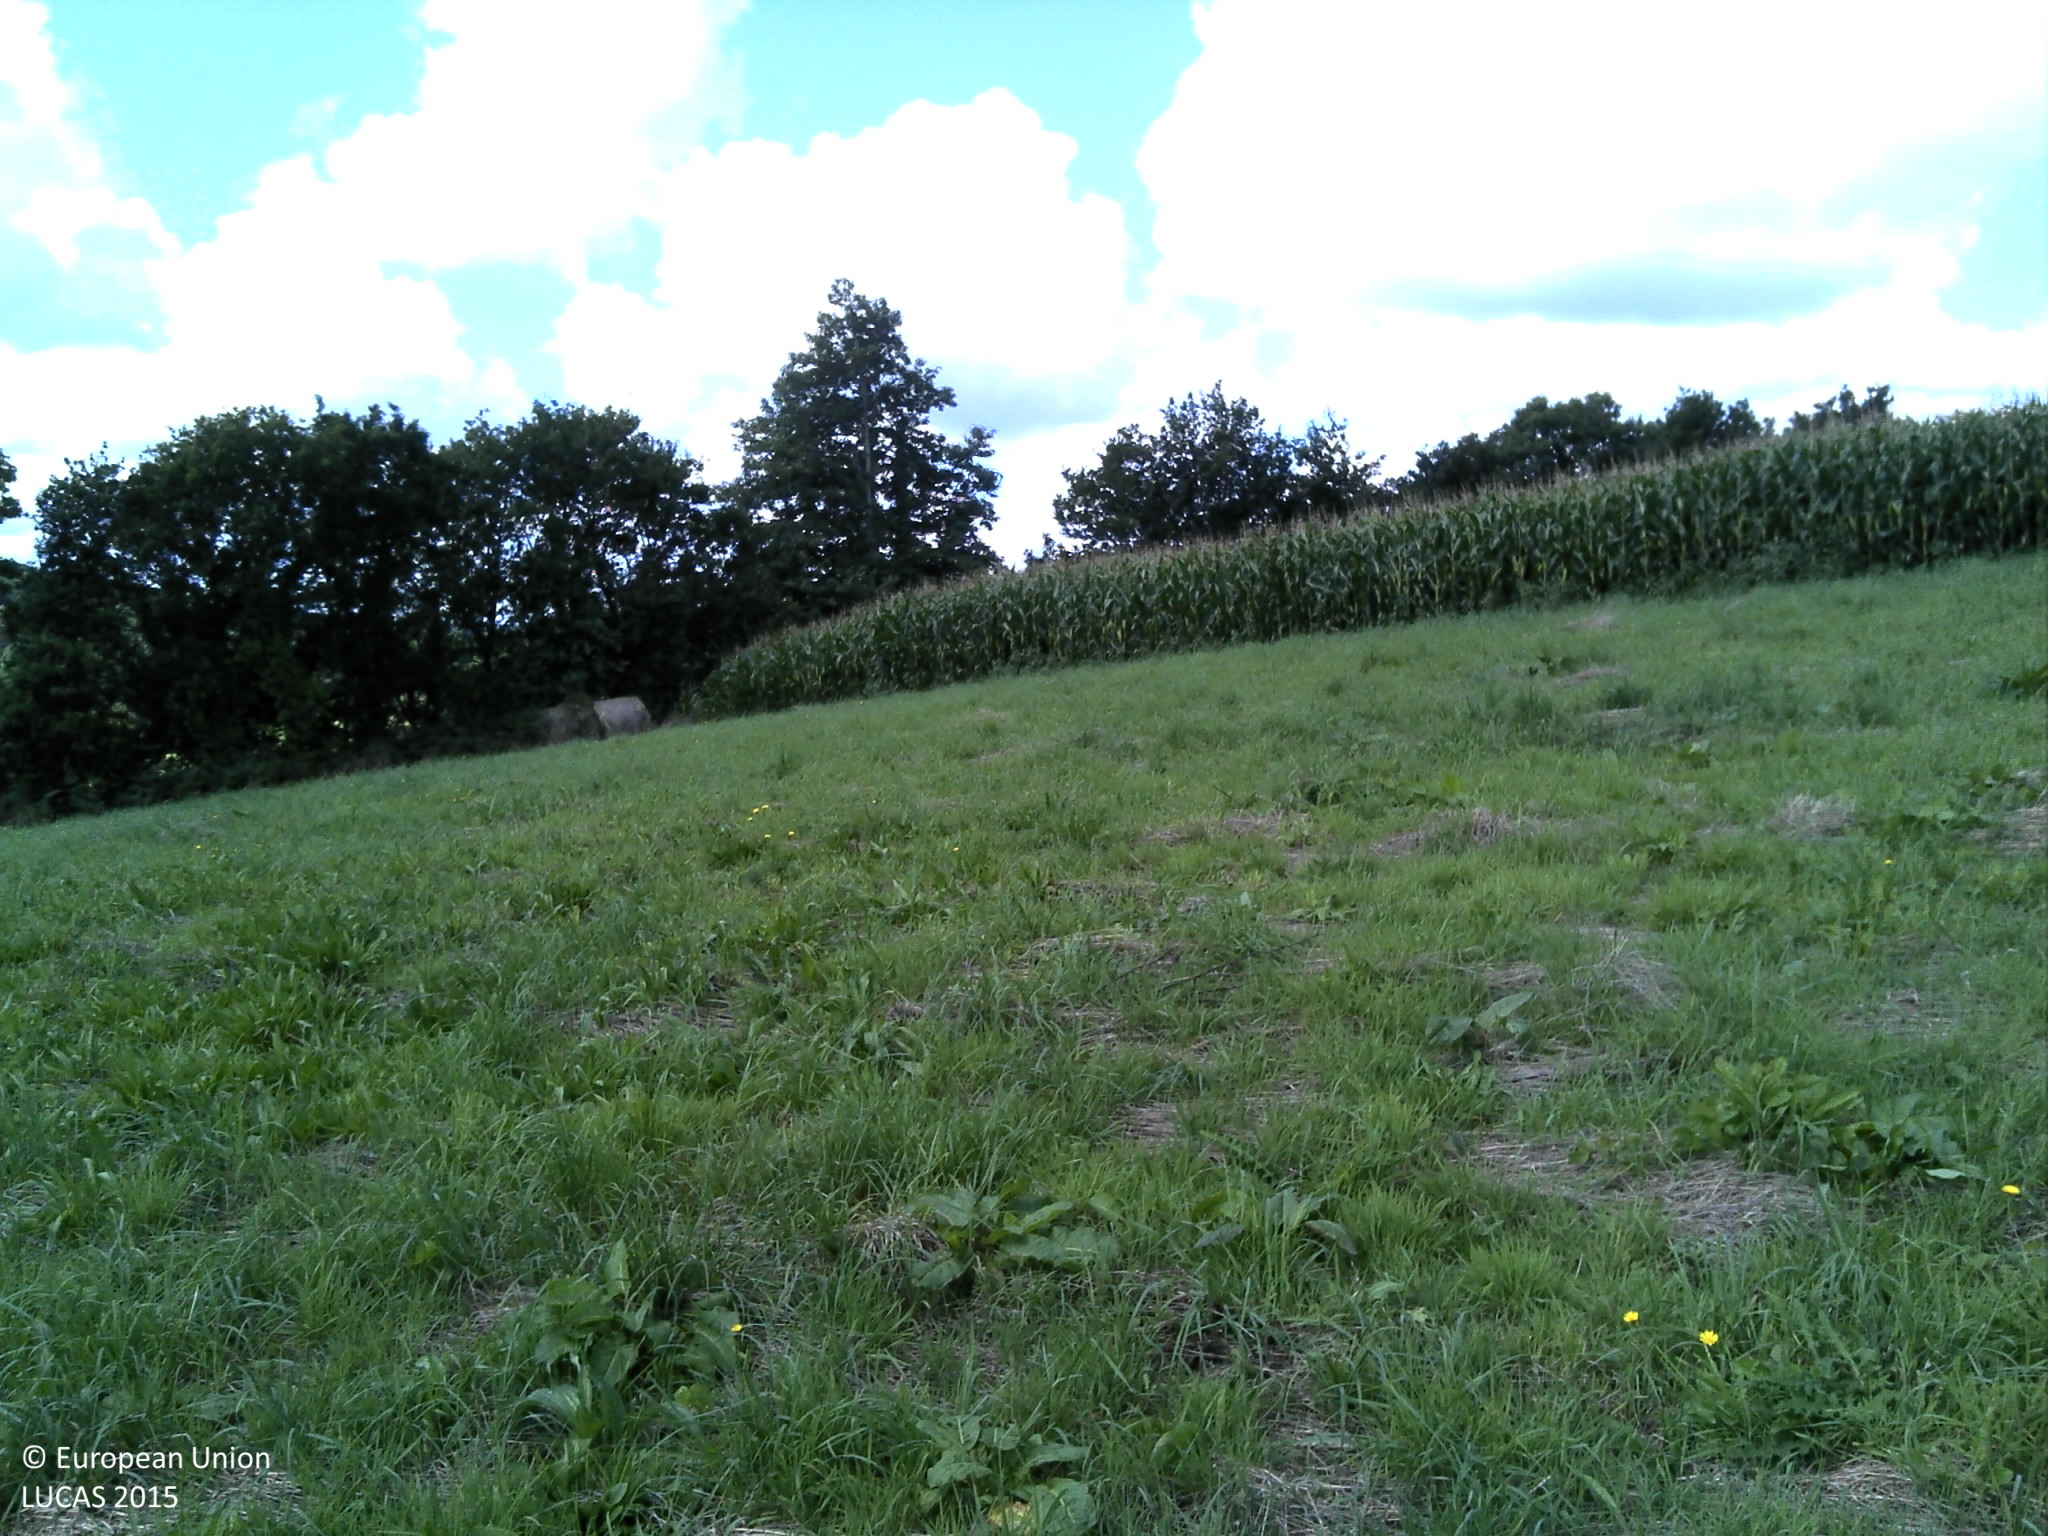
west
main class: Grassland
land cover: Grassland without tree/shrub cover
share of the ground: > 75 %
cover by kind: herbaceous plants 100 %
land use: Agriculture (excluding fallow land and kitchen gardens)
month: September
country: FR
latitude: 48.3972
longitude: -4.1790
